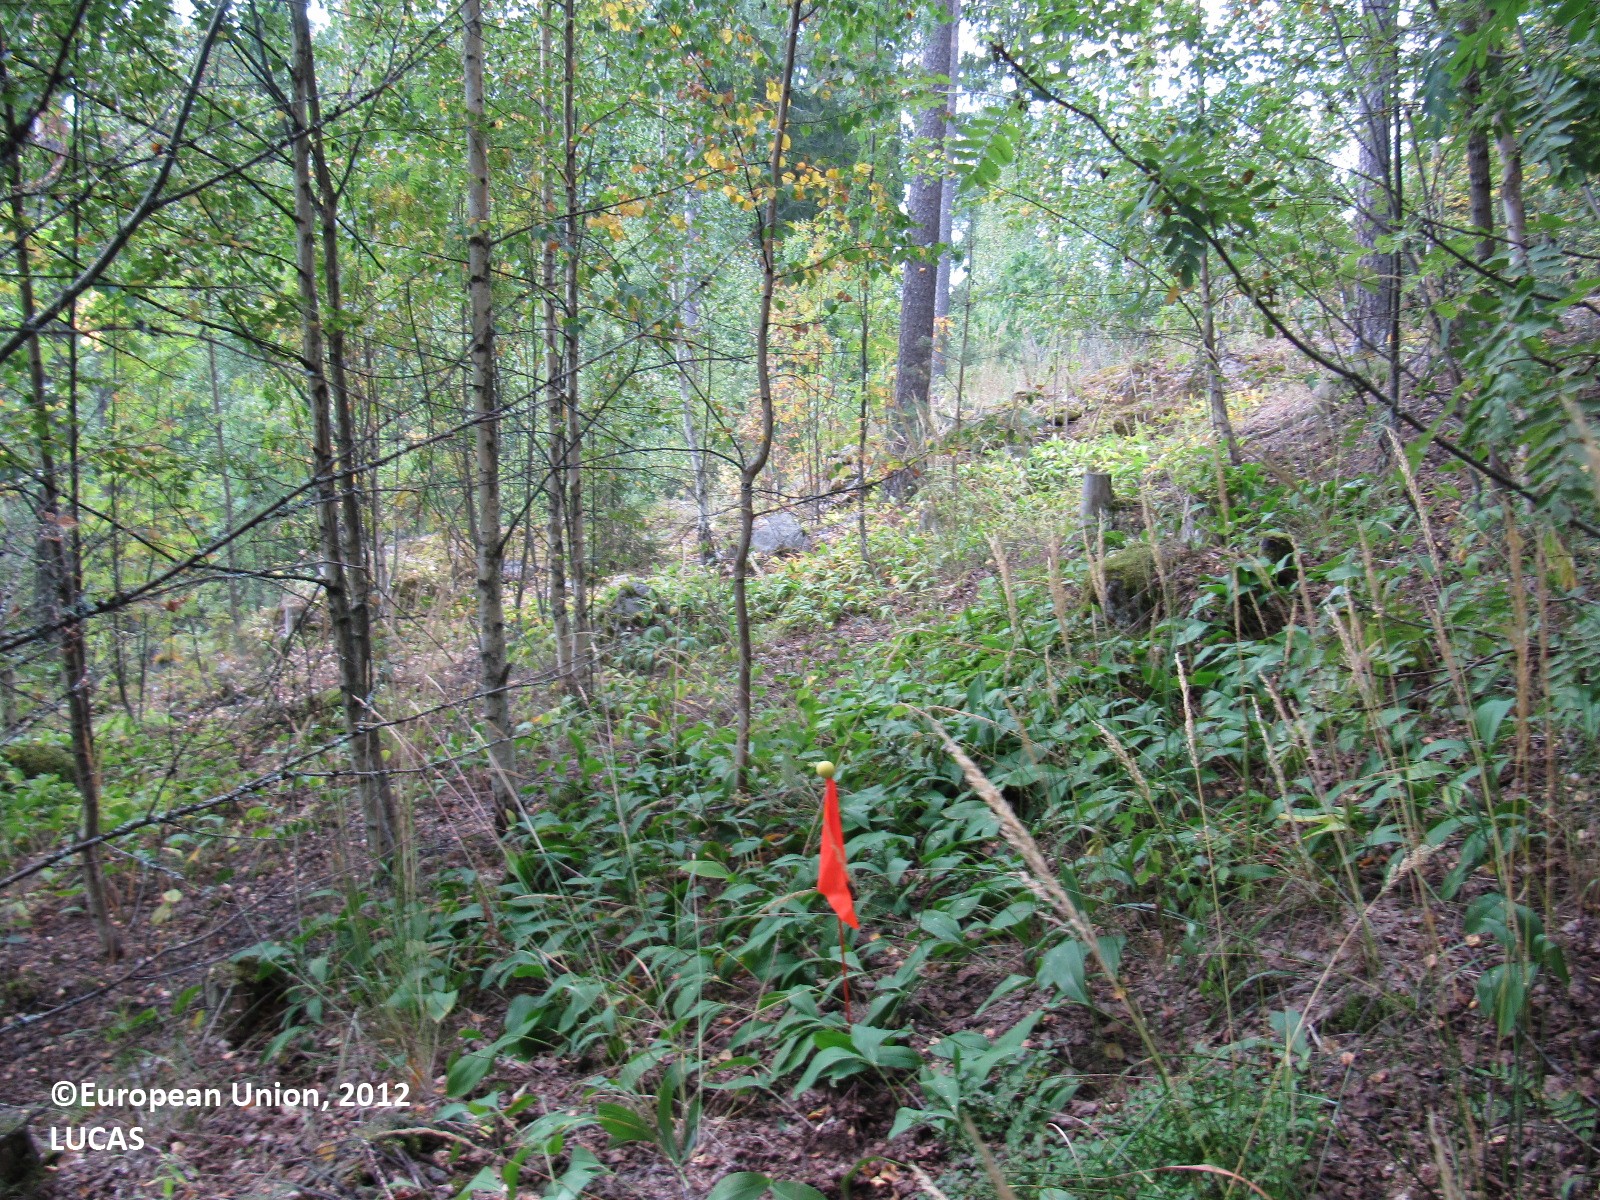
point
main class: Woodland
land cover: Broadleaved woodland
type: boreal forest
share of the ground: > 75 %
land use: Forestry
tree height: > 5 m
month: August
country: FI
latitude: 60.4306
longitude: 24.3649
